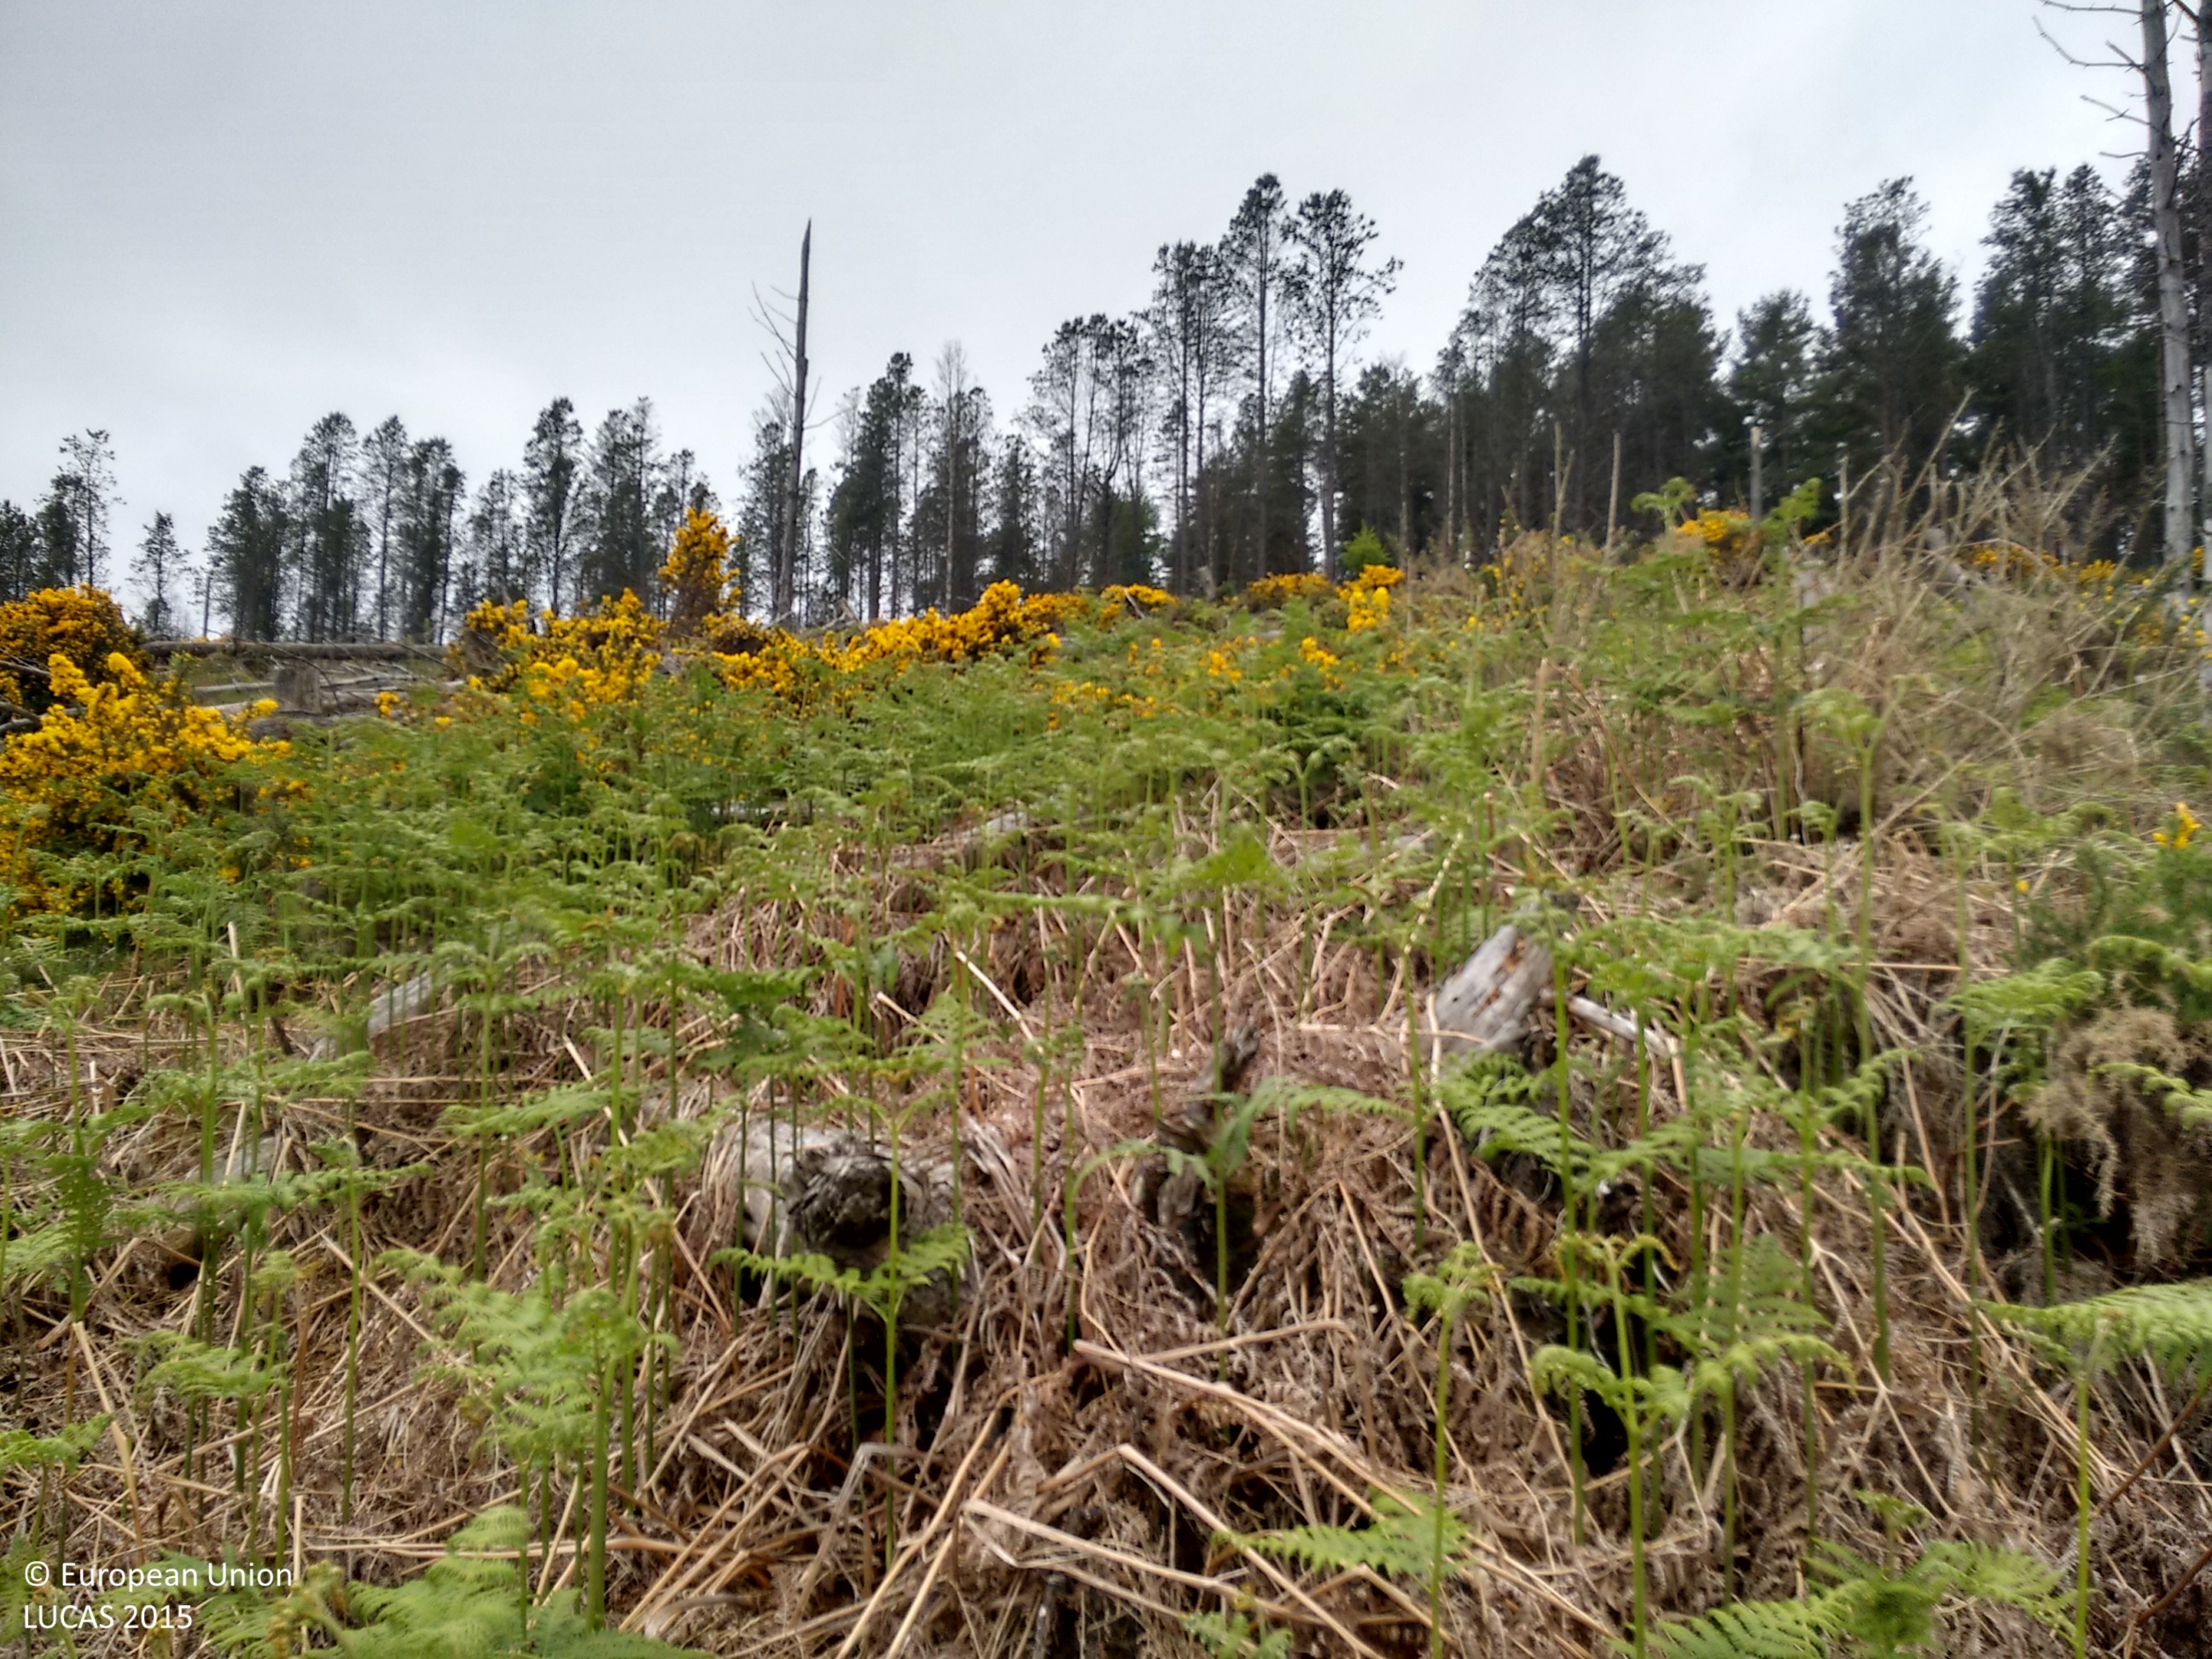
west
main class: Shrubland
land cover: Shrubland without tree cover
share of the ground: 50 - 75 %
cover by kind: shrubs 60 %, herbaceous plants 40 %
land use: Semi-natural and natural areas not in use
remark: Clear cut
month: June
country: GB
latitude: 57.1333
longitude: -2.7642
